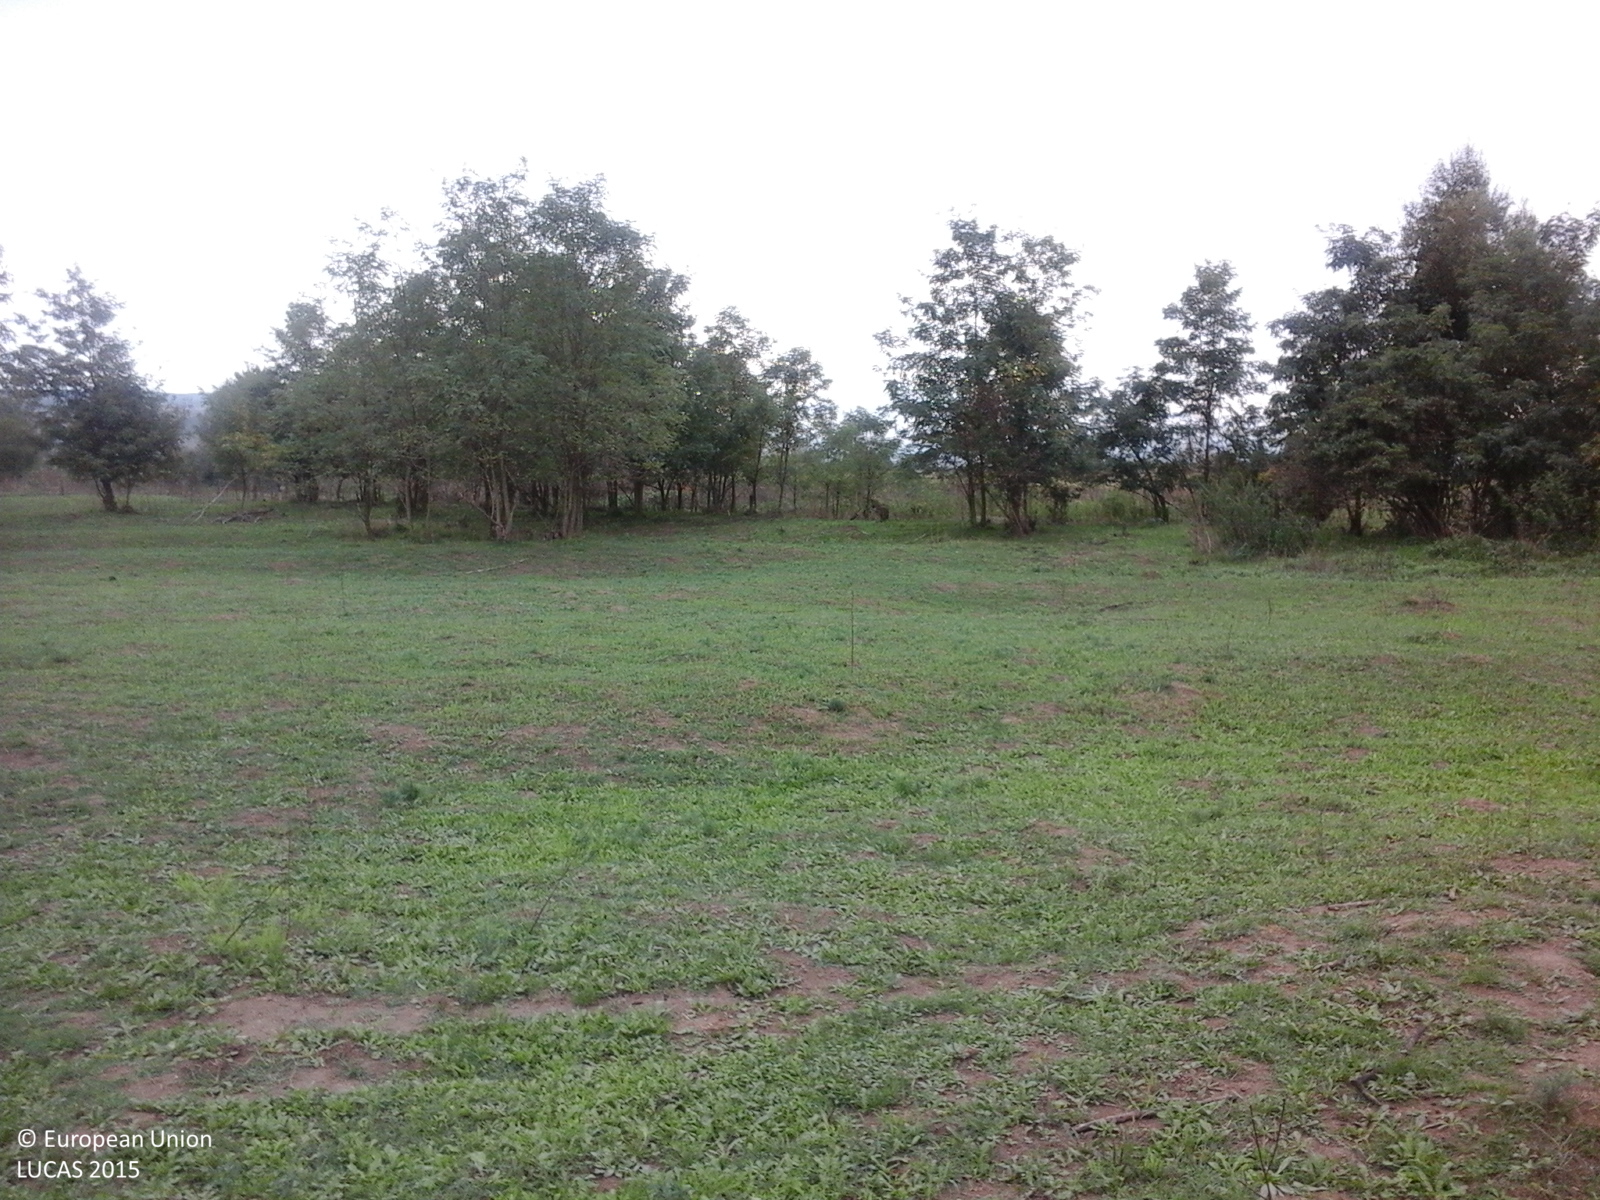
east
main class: Grassland
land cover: Grassland without tree/shrub cover
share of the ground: > 75 %
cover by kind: herbaceous plants 100 %
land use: Agriculture (excluding fallow land and kitchen gardens)
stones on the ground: < 10 %
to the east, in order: Grassland without tree/shrub cover; Broadleaved woodland; Spontaneously vegetated surfaces; Tracks; Spontaneously vegetated surfaces; Rape and turnip rape
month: September
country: RO
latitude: 45.6326
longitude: 22.0338
